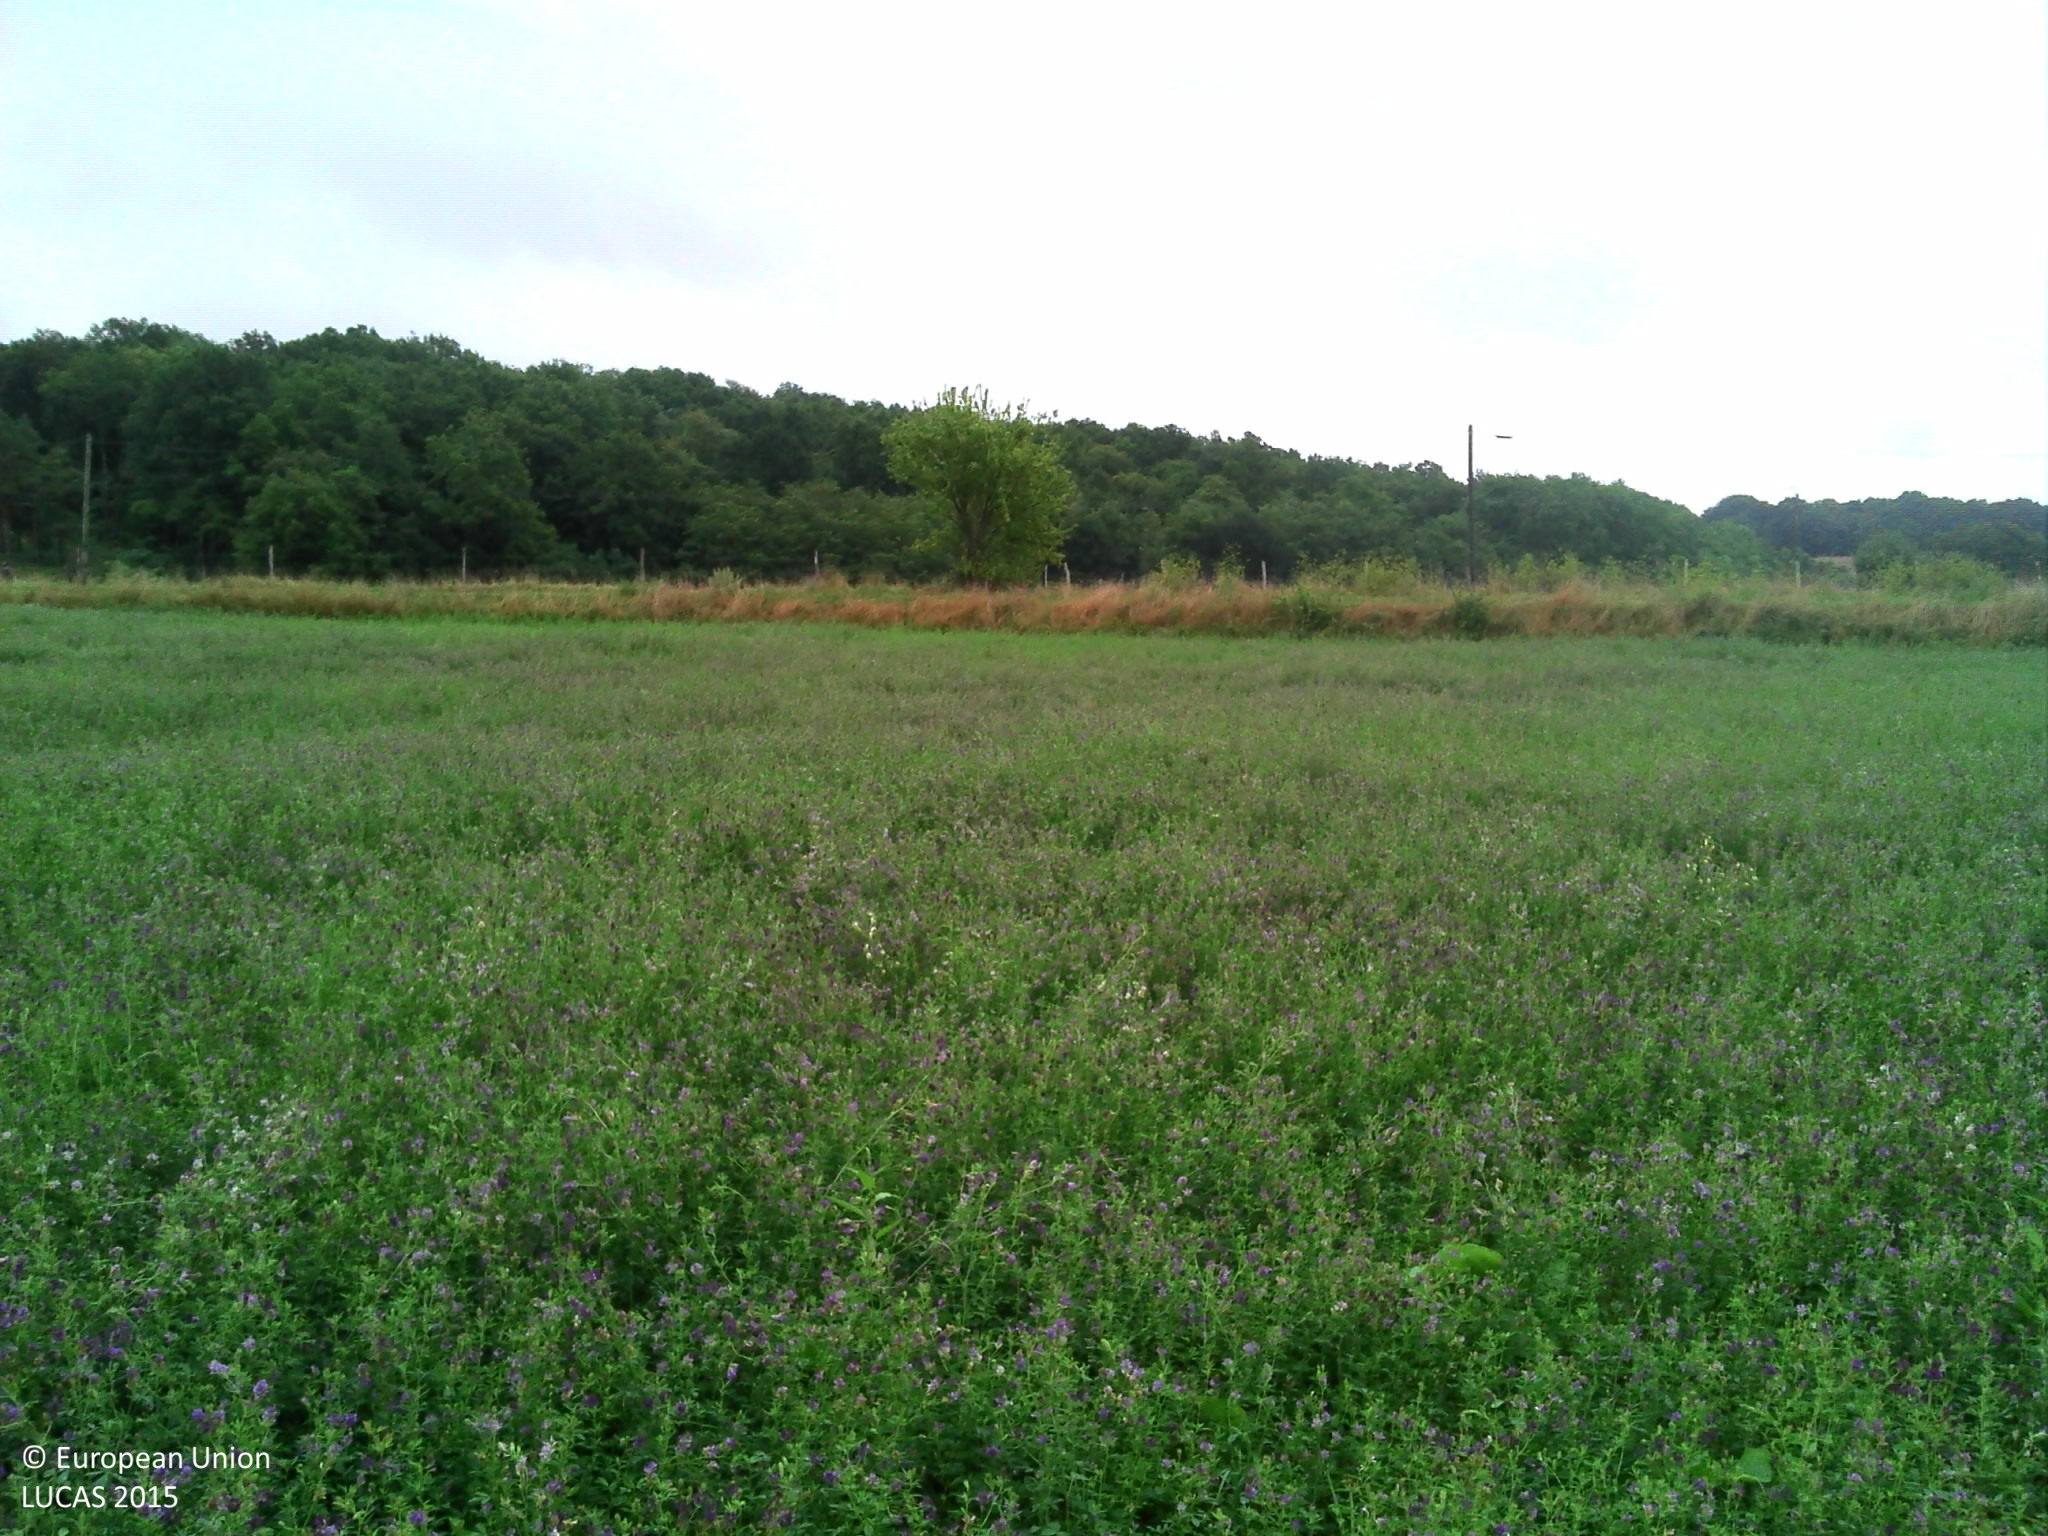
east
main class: Cropland
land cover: Lucerne
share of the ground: > 75 %
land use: Agriculture (excluding fallow land and kitchen gardens)
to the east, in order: Lucerne; Grass margins; Paved roads, cycling and walking lanes; Grass margins; Ditches and canals; Electric lines; Single bushes/trees; Fences; Grassland without tree/shrub cover; Electric lines; Grassland without tree/shrub cover; Fences; Broadleaved woodland
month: August
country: FR
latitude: 45.5064
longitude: 0.6576
